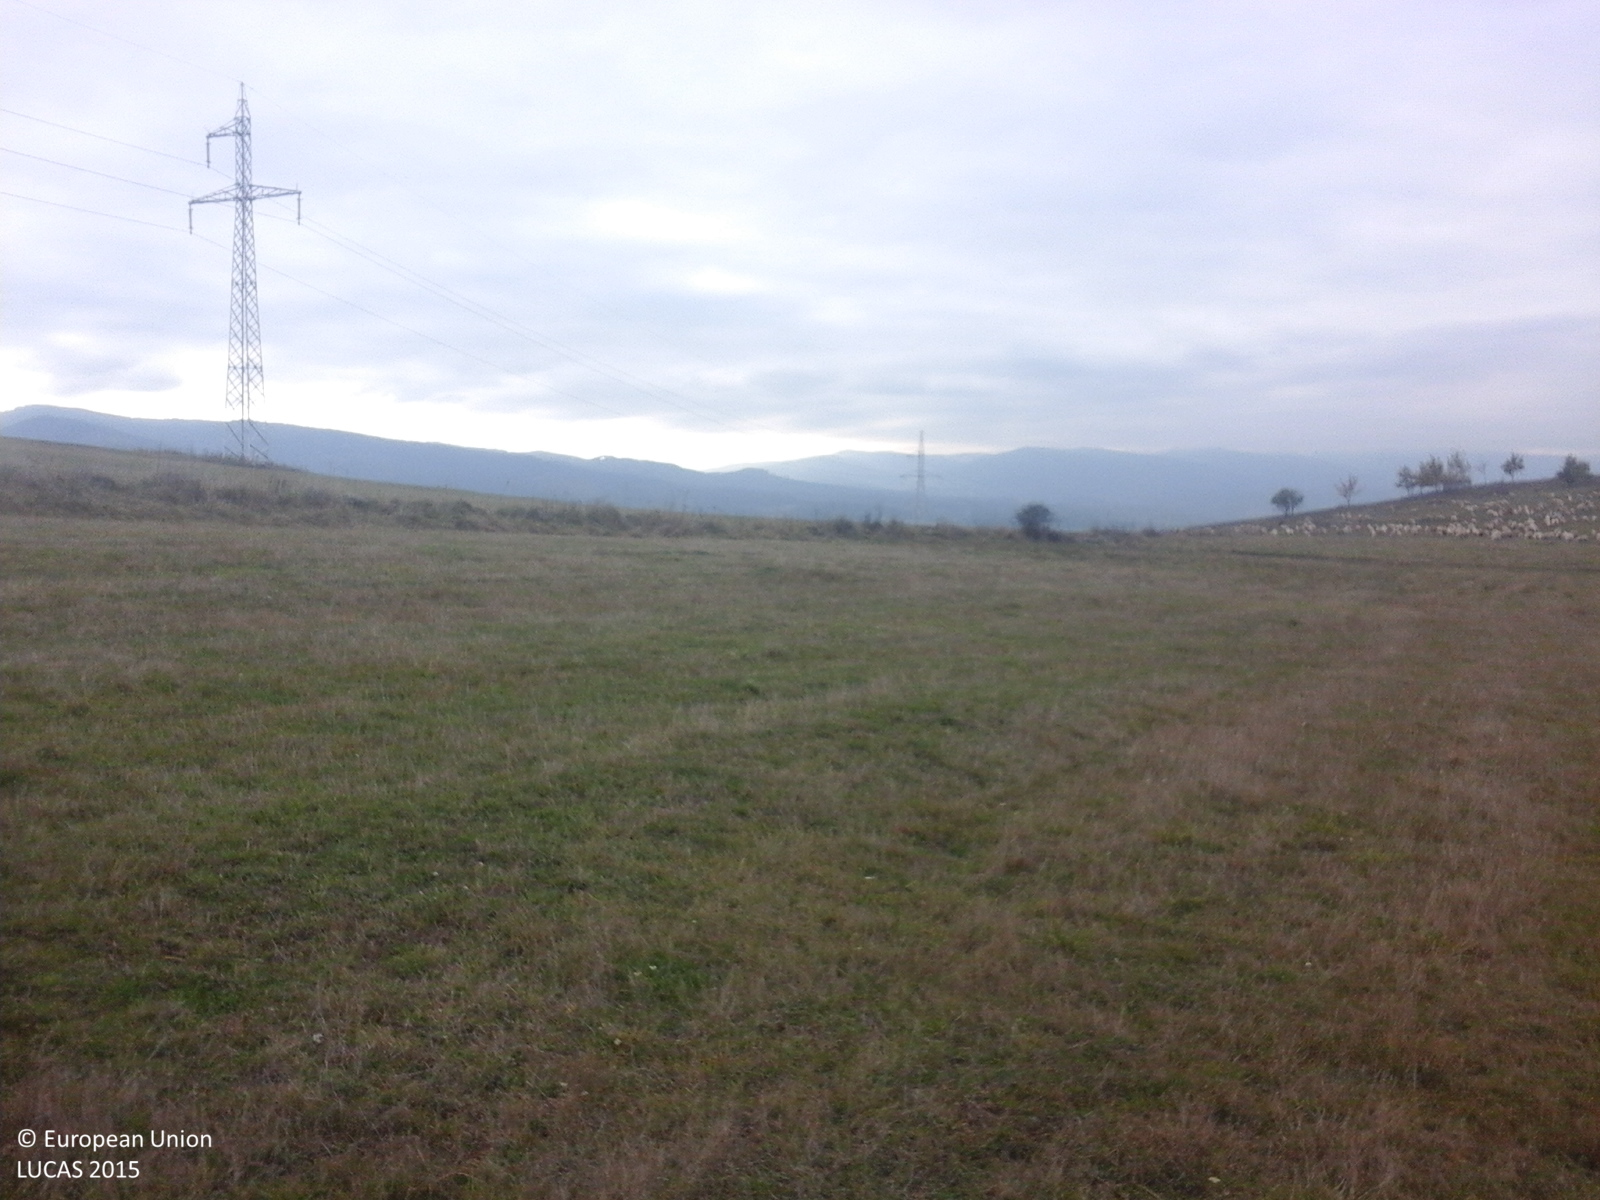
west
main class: Grassland
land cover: Grassland without tree/shrub cover
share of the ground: > 75 %
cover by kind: herbaceous plants 100 %
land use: Agriculture (excluding fallow land and kitchen gardens)
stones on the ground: < 10 %
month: October
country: RO
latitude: 46.3379
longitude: 25.8223
